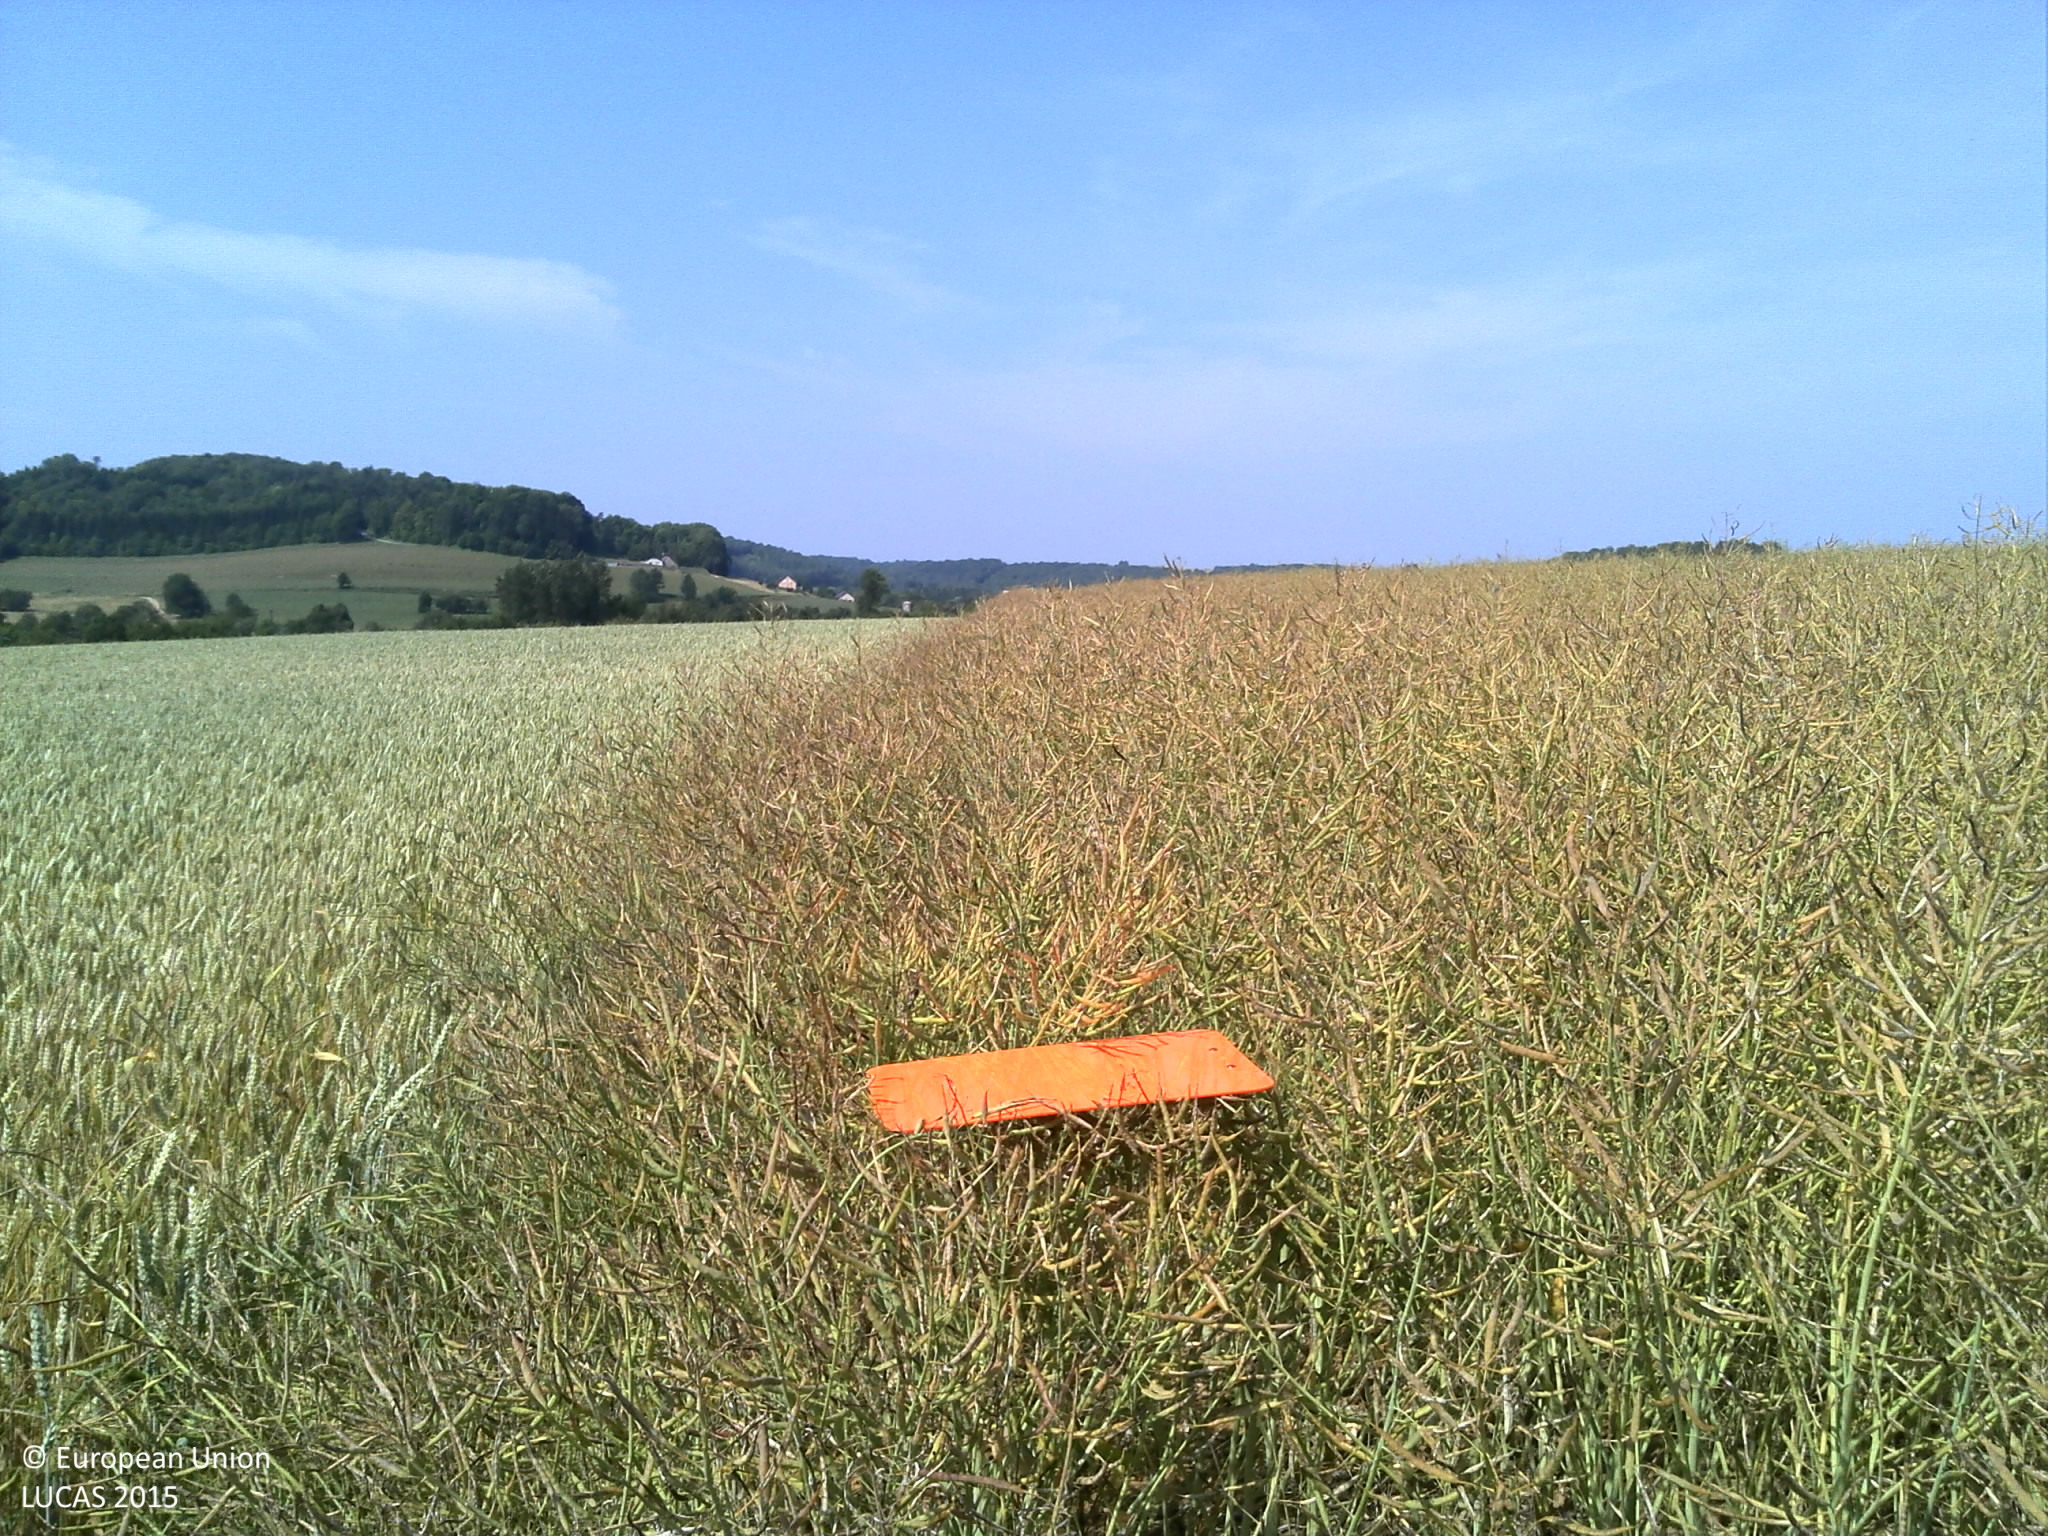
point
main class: Cropland
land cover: Rape and turnip rape
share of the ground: > 75 %
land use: Agriculture (excluding fallow land and kitchen gardens)
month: July
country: FR
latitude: 49.7790
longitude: 4.4549
